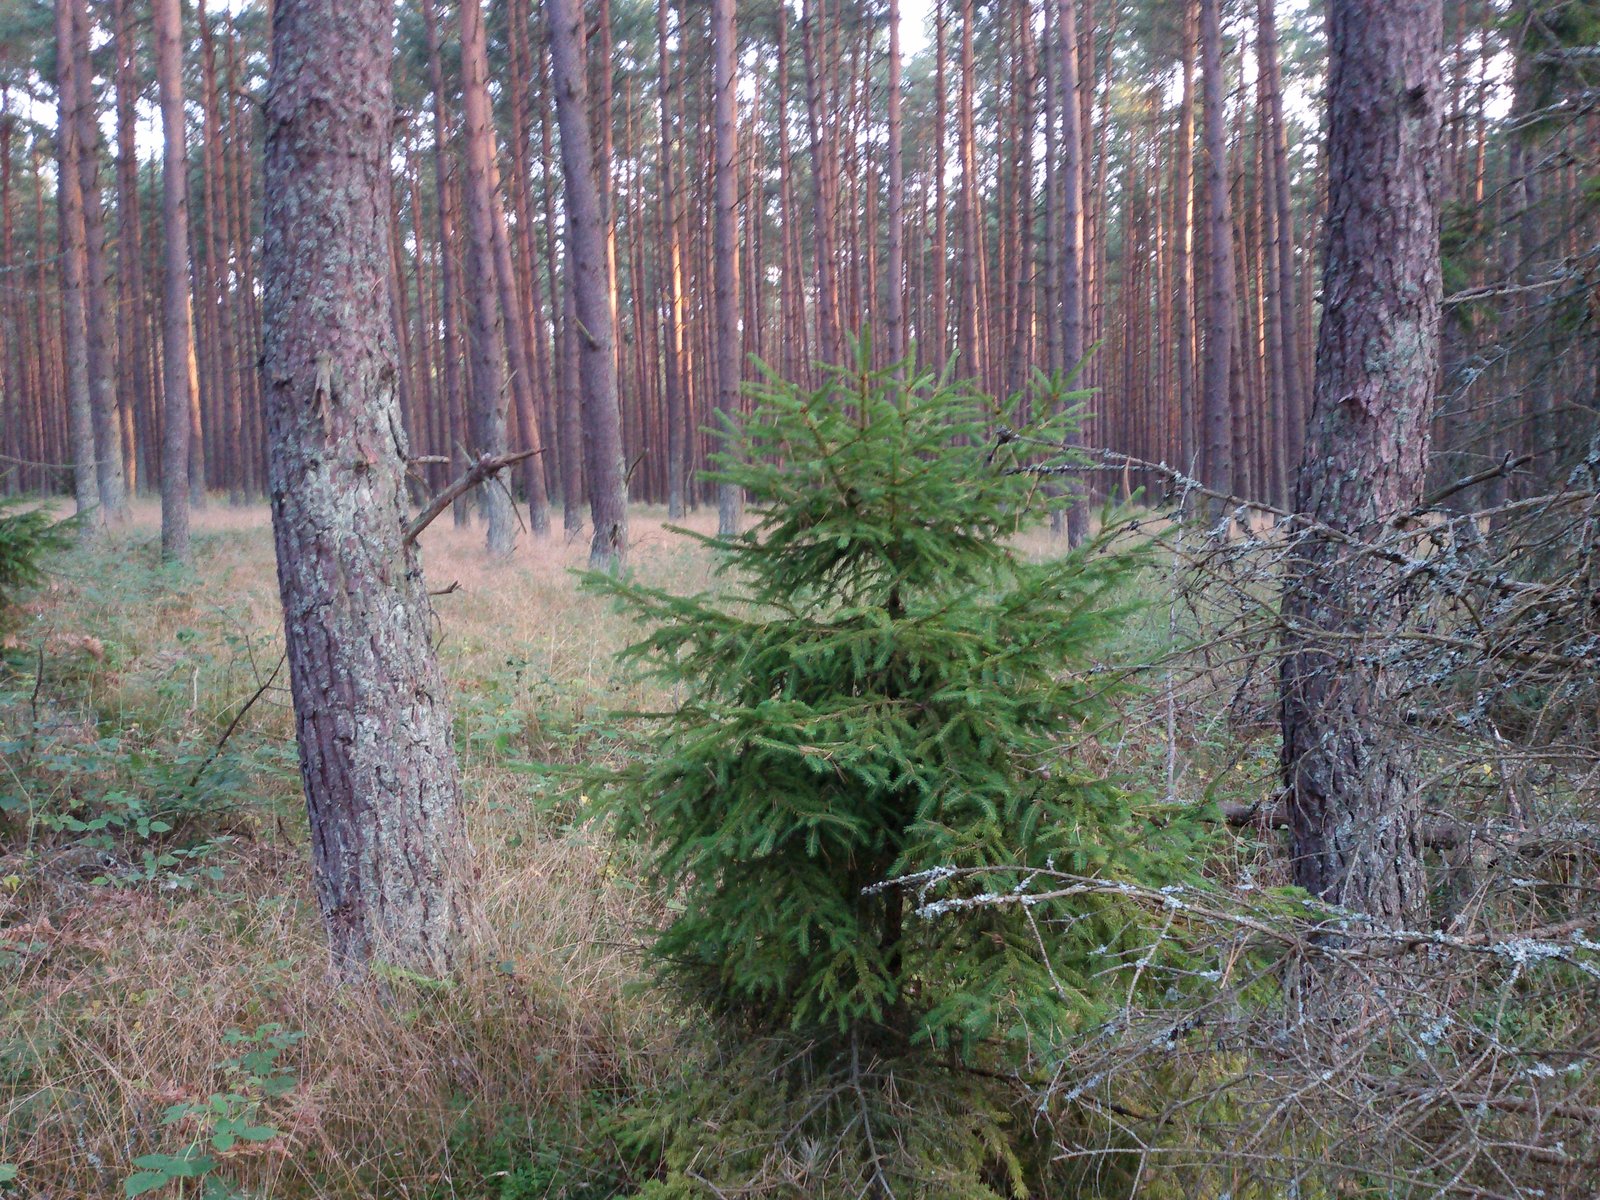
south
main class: Woodland
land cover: Pine dominated coniferous woodland
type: hemiboreal forest and nemoral coniferous forest and mixed broadleaved-coniferous forest
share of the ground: 50 - 75 %
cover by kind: coniferous forest trees 65 %, herbaceous plants 25 %, shrubs 5 %, lichens and mosses 5 %
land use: Forestry
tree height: > 5 m
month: August
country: PL
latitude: 53.8035
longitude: 17.1613
